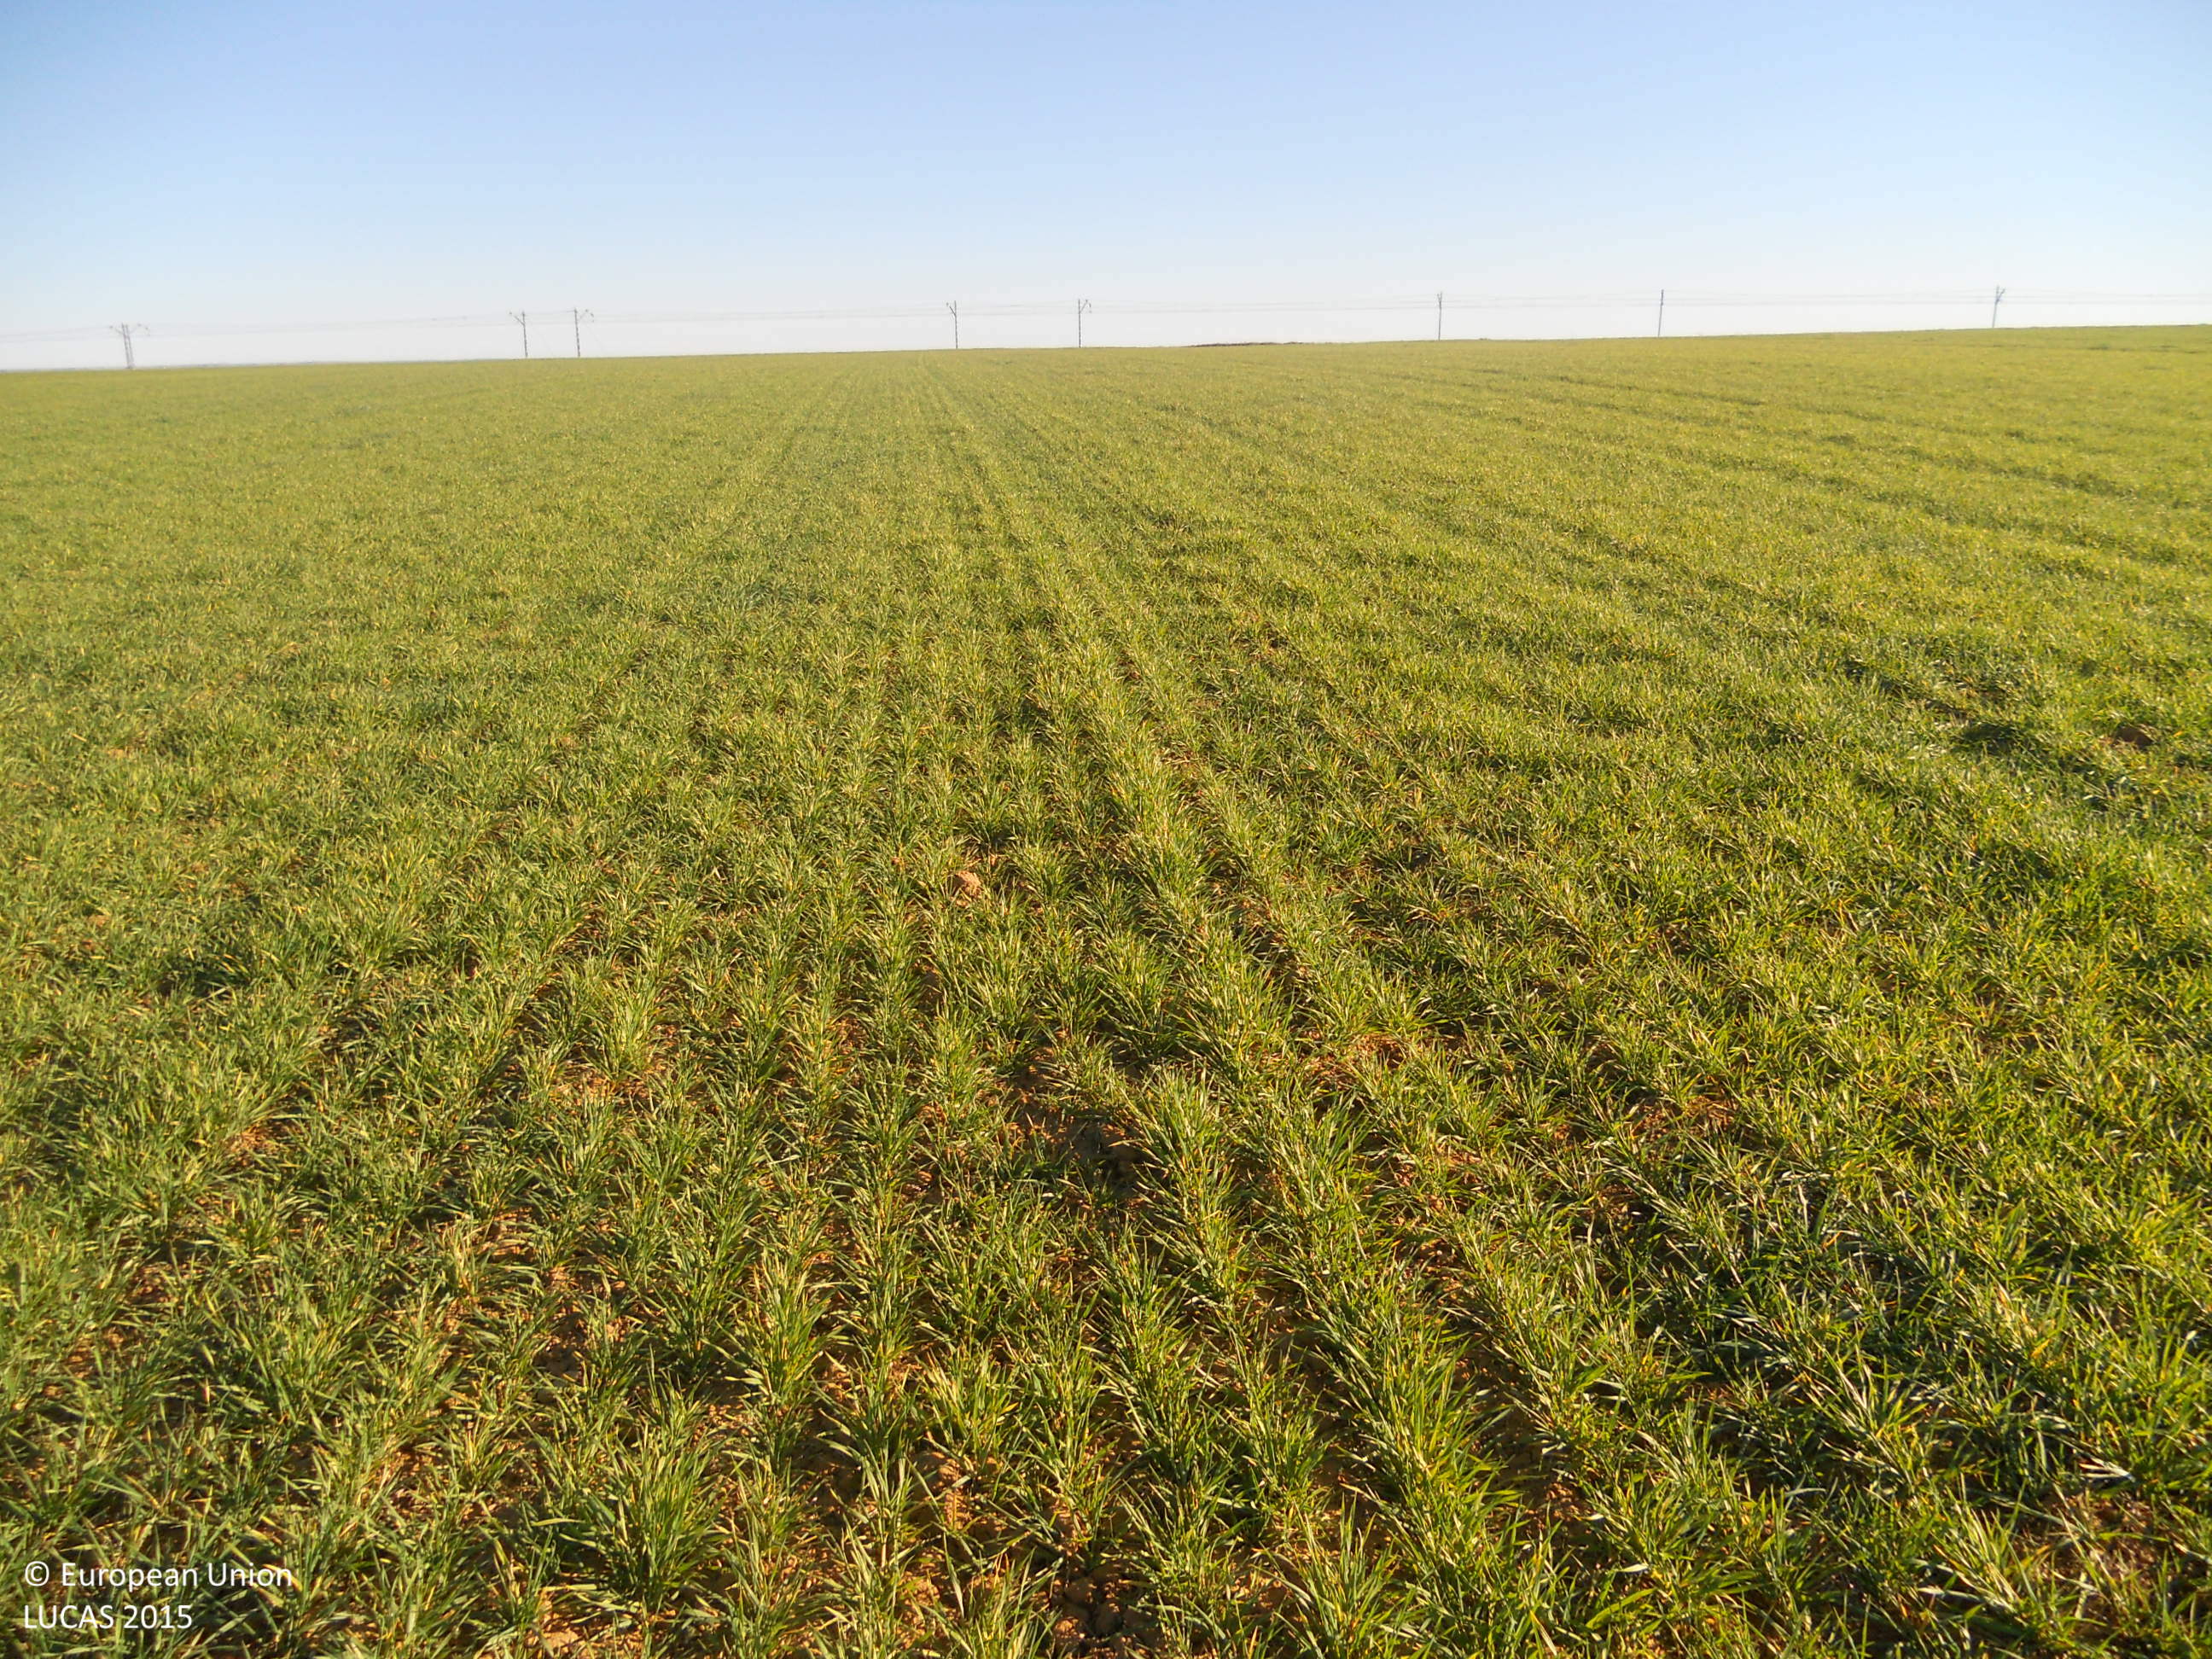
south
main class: Cropland
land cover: Barley
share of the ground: > 75 %
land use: Agriculture (excluding fallow land and kitchen gardens)
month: March
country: ES
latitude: 42.1813
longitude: -4.8117
